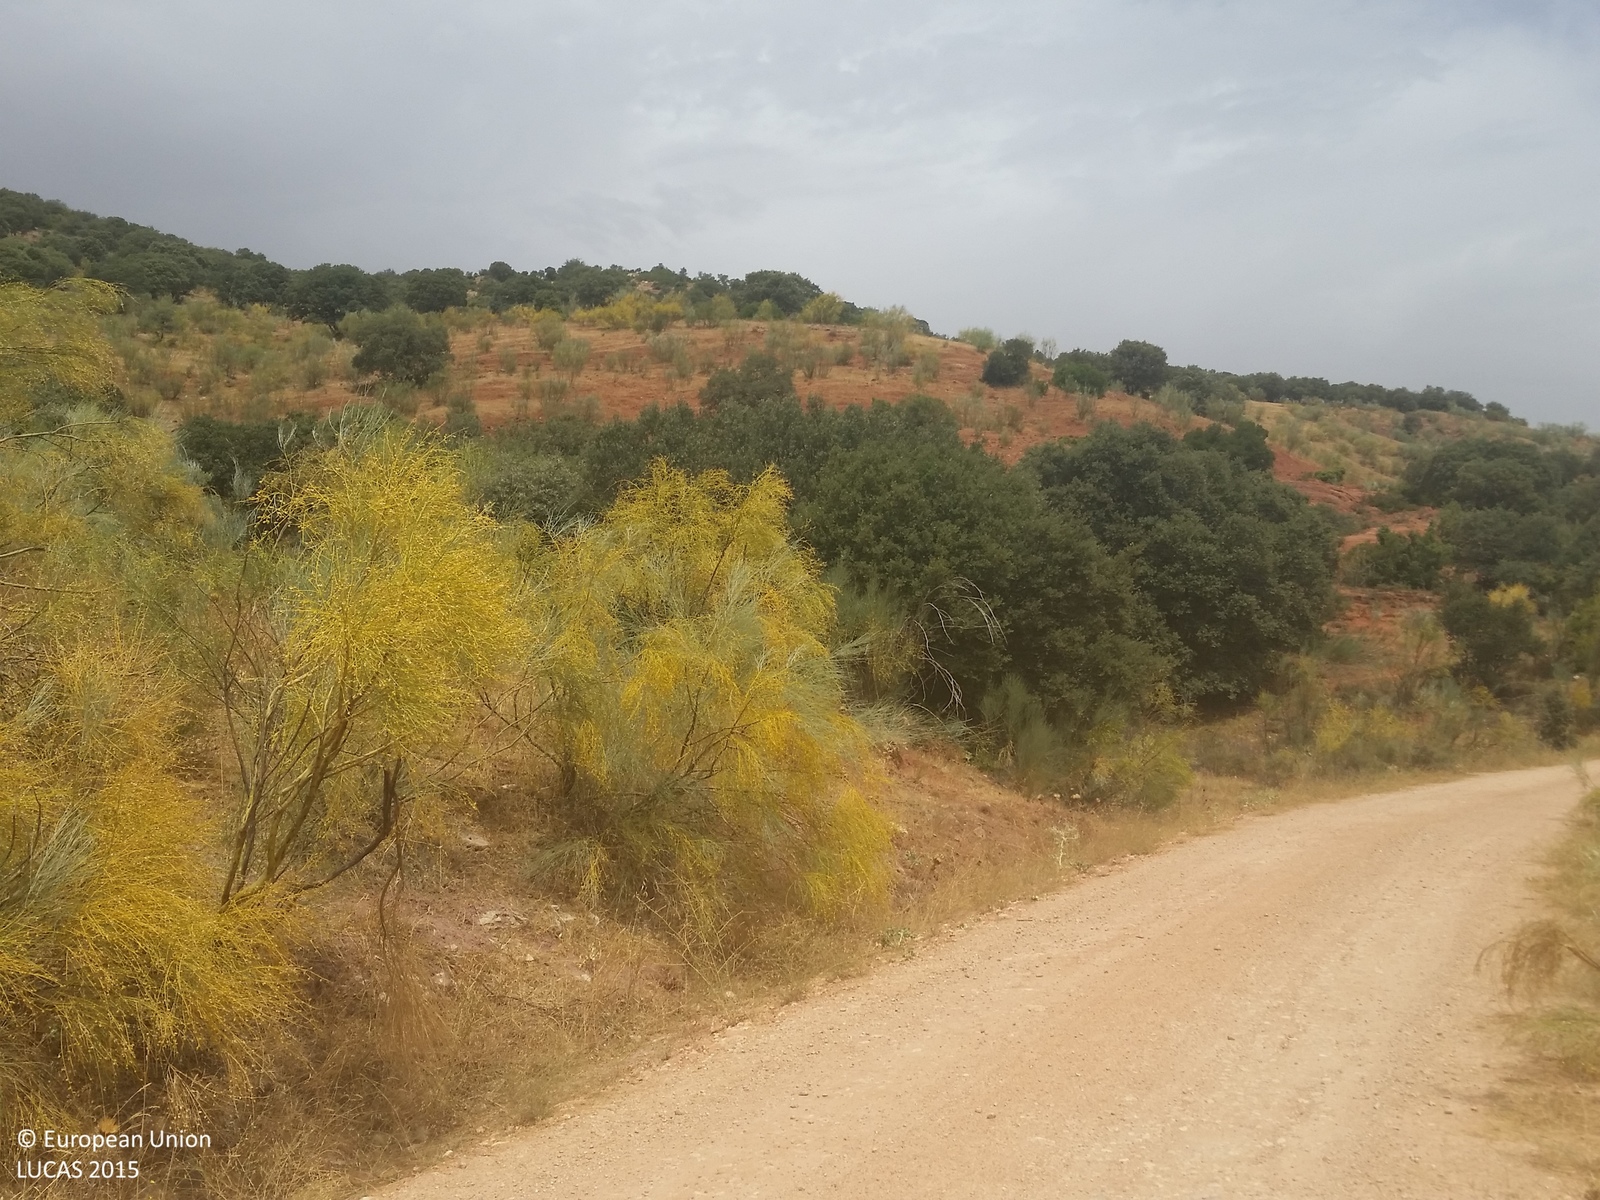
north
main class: Woodland
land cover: Broadleaved woodland
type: acidophilous oak and oak-birch forest
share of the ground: 50 - 75 %
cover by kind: broadleaved forest trees 50 %, shrubs 20 %, herbaceous plants 15 %, consolidated bare surface 15 %
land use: Semi-natural and natural areas not in use
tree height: < 5 m
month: August
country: ES
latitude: 38.6812
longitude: -2.4736
